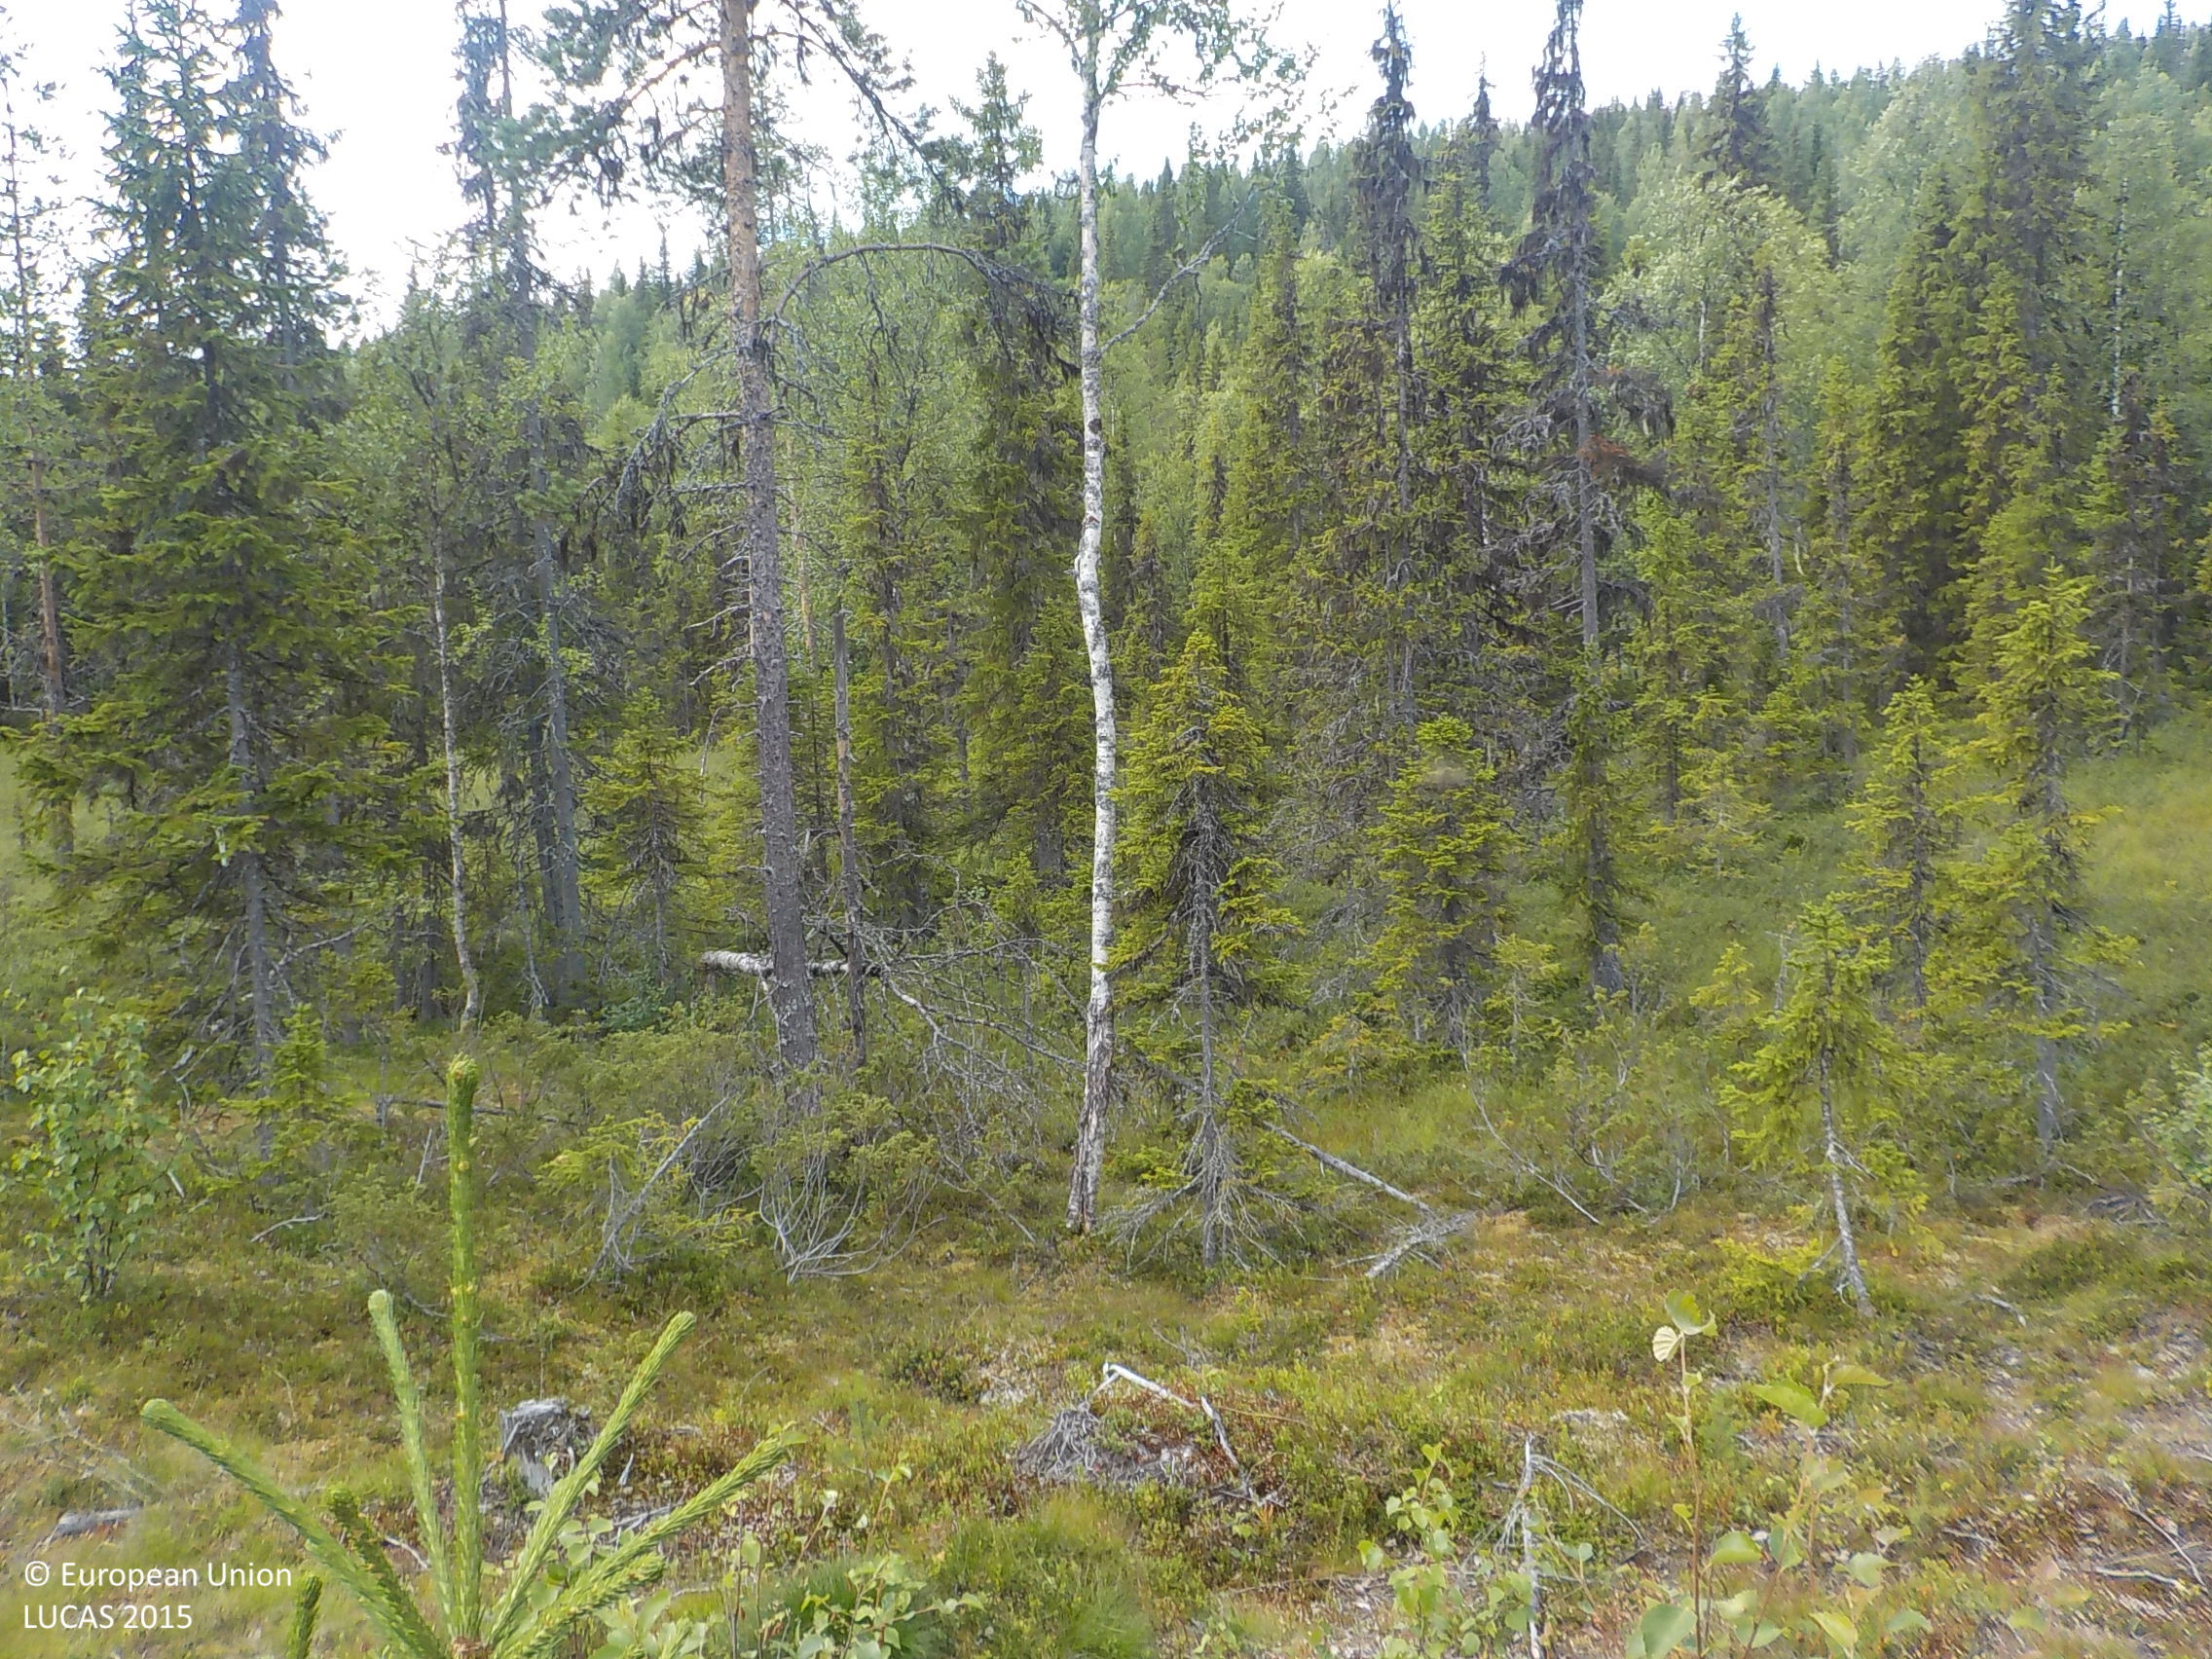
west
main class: Woodland
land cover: Spruce dominated mixed woodland
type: boreal forest
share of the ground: 25 - 50 %
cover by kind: herbaceous plants 60 %, coniferous forest trees 20 %, broadleaved forest trees 10 %, shrubs 5 %, lichens and mosses 5 %
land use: Forestry
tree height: < 5 m
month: August
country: SE
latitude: 64.1238
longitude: 17.6301
